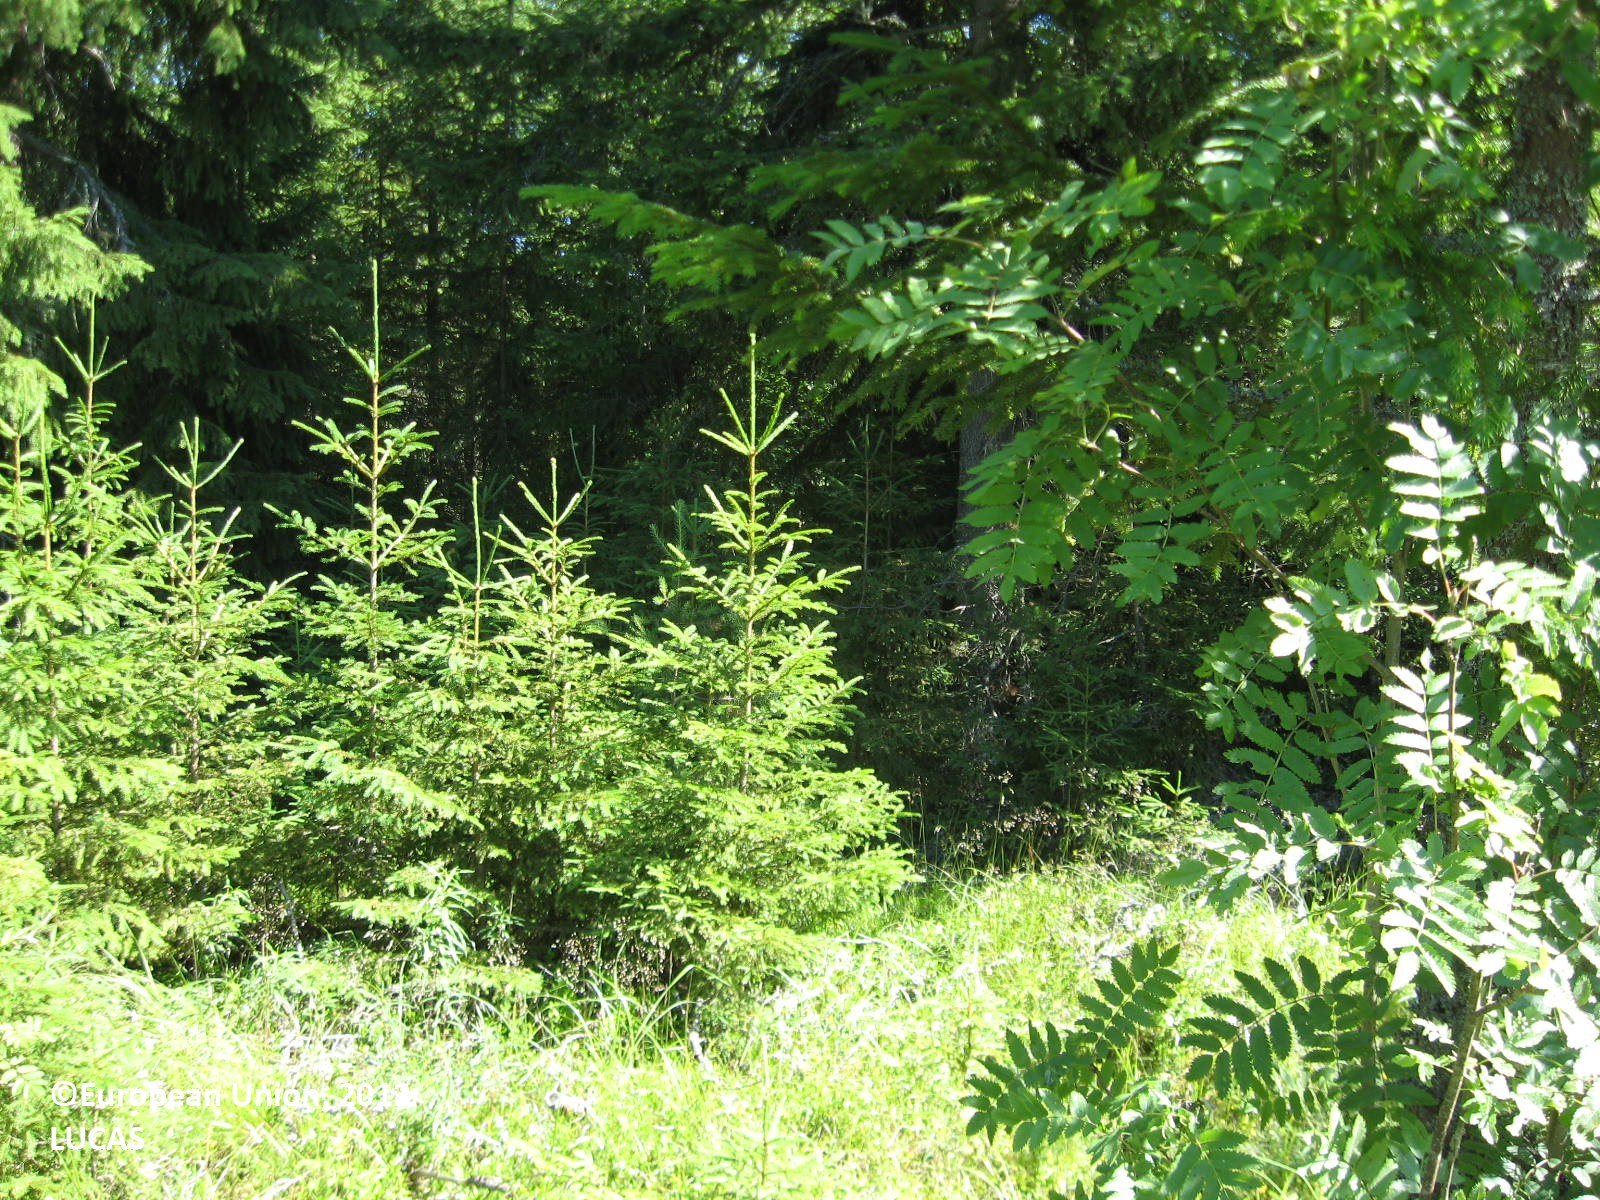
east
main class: Woodland
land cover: Spruce dominated mixed woodland
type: boreal forest
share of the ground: 50 - 75 %
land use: Energy production
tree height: > 5 m
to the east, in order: Spruce dominated mixed woodland; Temporary grasslands; Mixed cereals for fodder; Grassland without tree/shrub cover; Broadleaved woodland; Inland running water; Broadleaved woodland; Tracks; Potatoes; Other mixed woodland
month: July
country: FI
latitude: 62.1578
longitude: 21.6595
